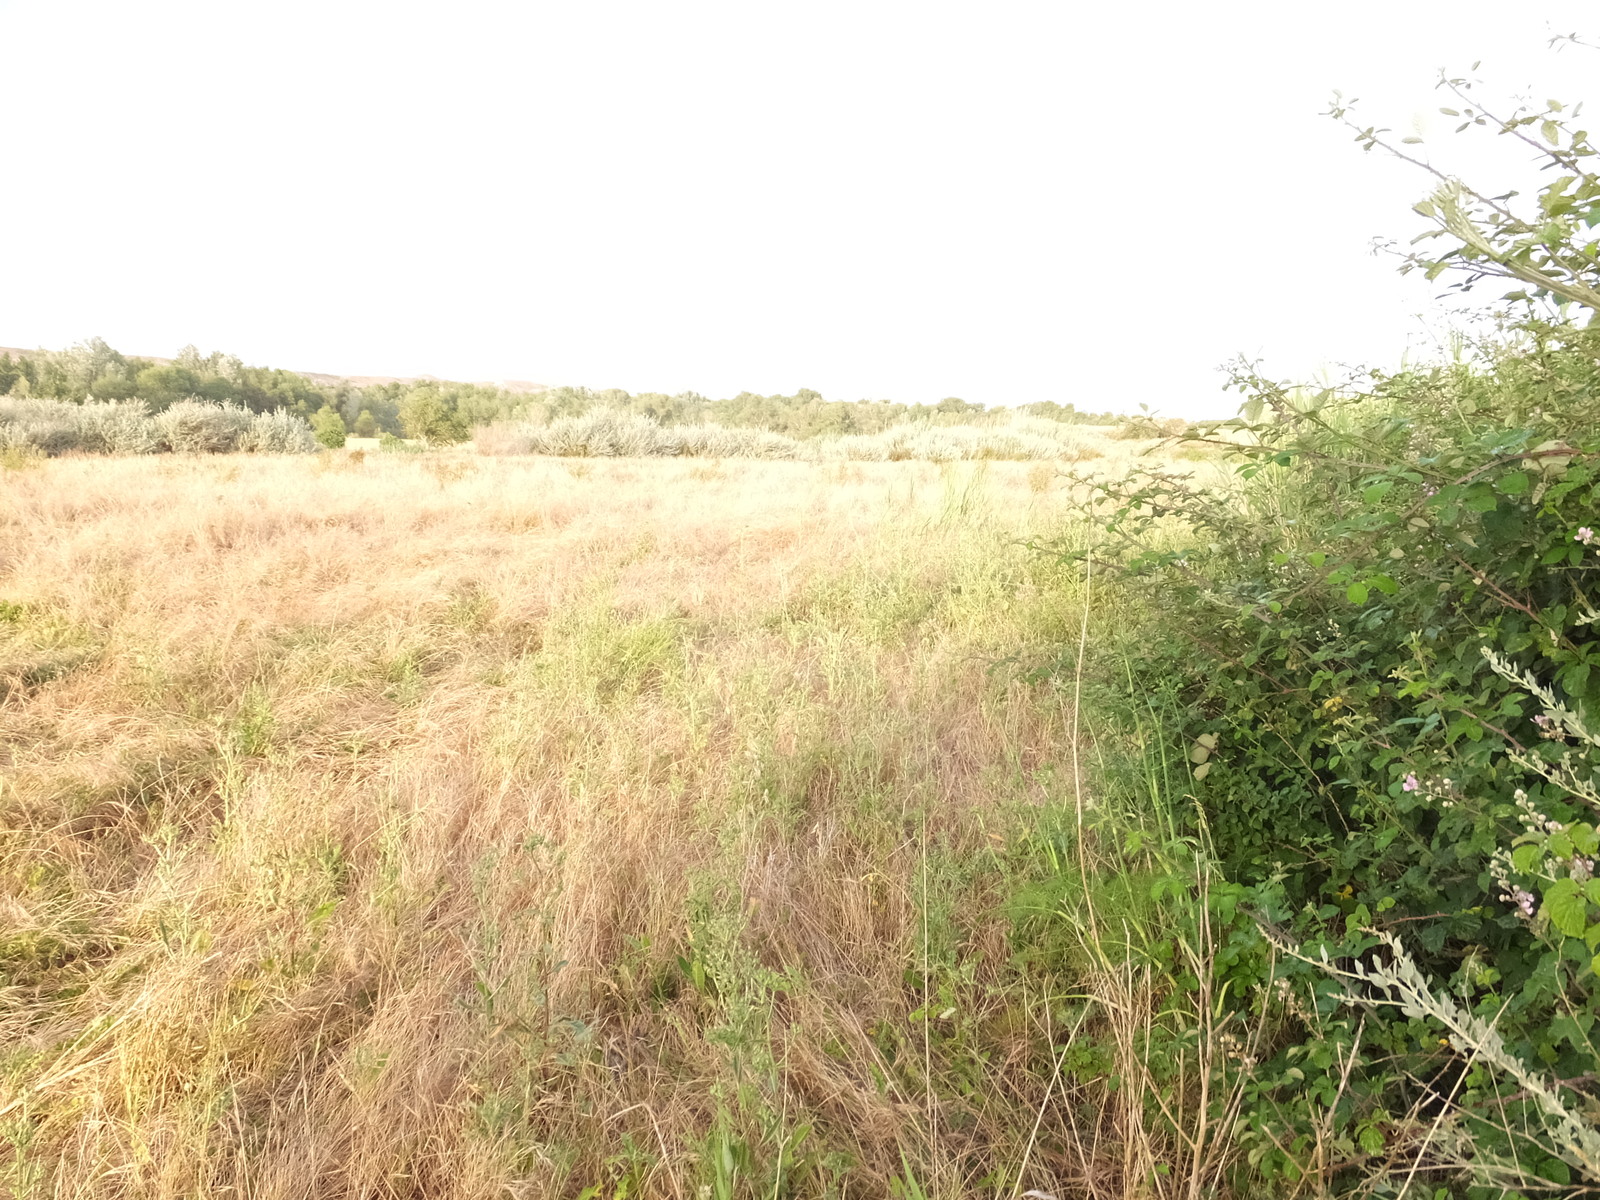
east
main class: Grassland
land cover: Grassland with sparse tree/shrub cover
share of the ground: > 75 %
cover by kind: herbaceous plants 85 %, shrubs 10 %, broadleaved forest trees 5 %
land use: Semi-natural and natural areas not in use
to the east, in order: Grassland with sparse tree/shrub cover; Common wheat; Shruby margins; Common wheat; Shrubland with sparse tree cover; Tracks; Shrubland with sparse tree cover; Common wheat; Shruby margins; Common wheat; Shruby margins; Shrubland with sparse tree cover
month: June
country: ES
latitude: 41.6899
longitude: 0.0480
